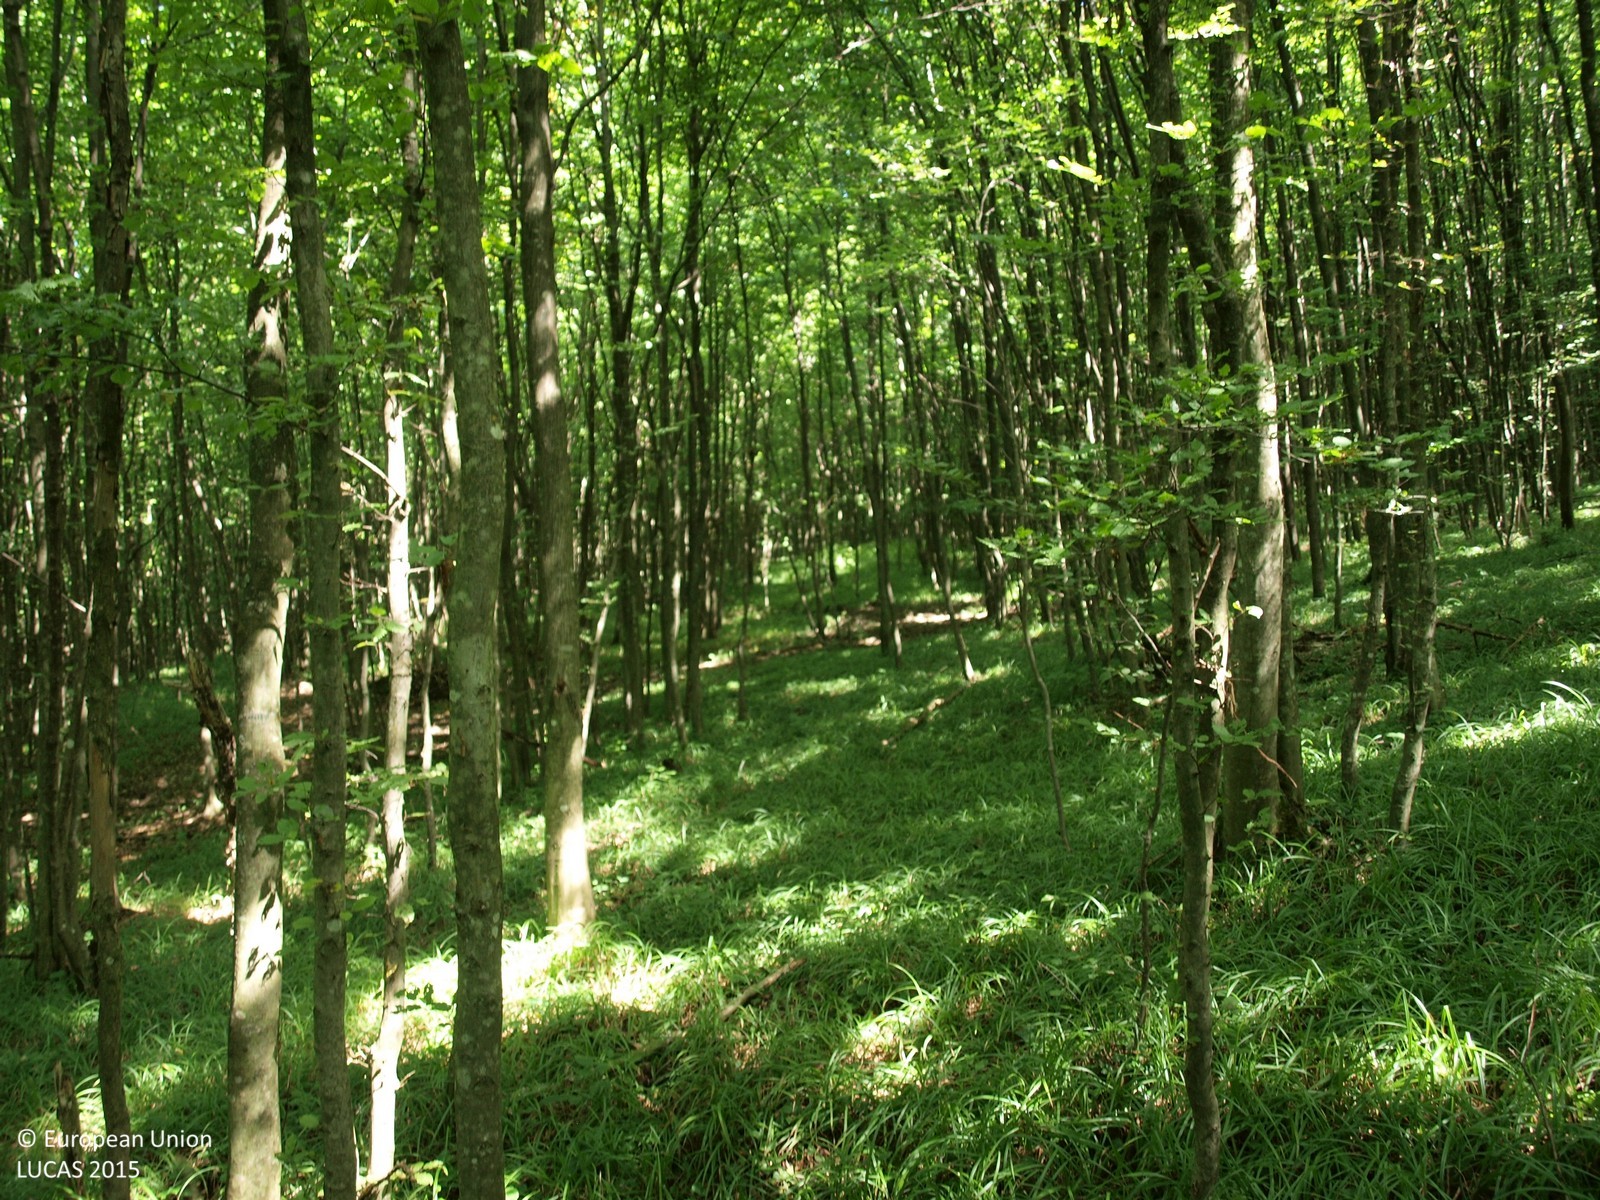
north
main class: Woodland
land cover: Broadleaved woodland
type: mesophytic deciduous forest
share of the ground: > 75 %
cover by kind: broadleaved forest trees 100 %
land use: Forestry
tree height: > 5 m
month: August
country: HR
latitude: 46.0154
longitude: 16.3929
